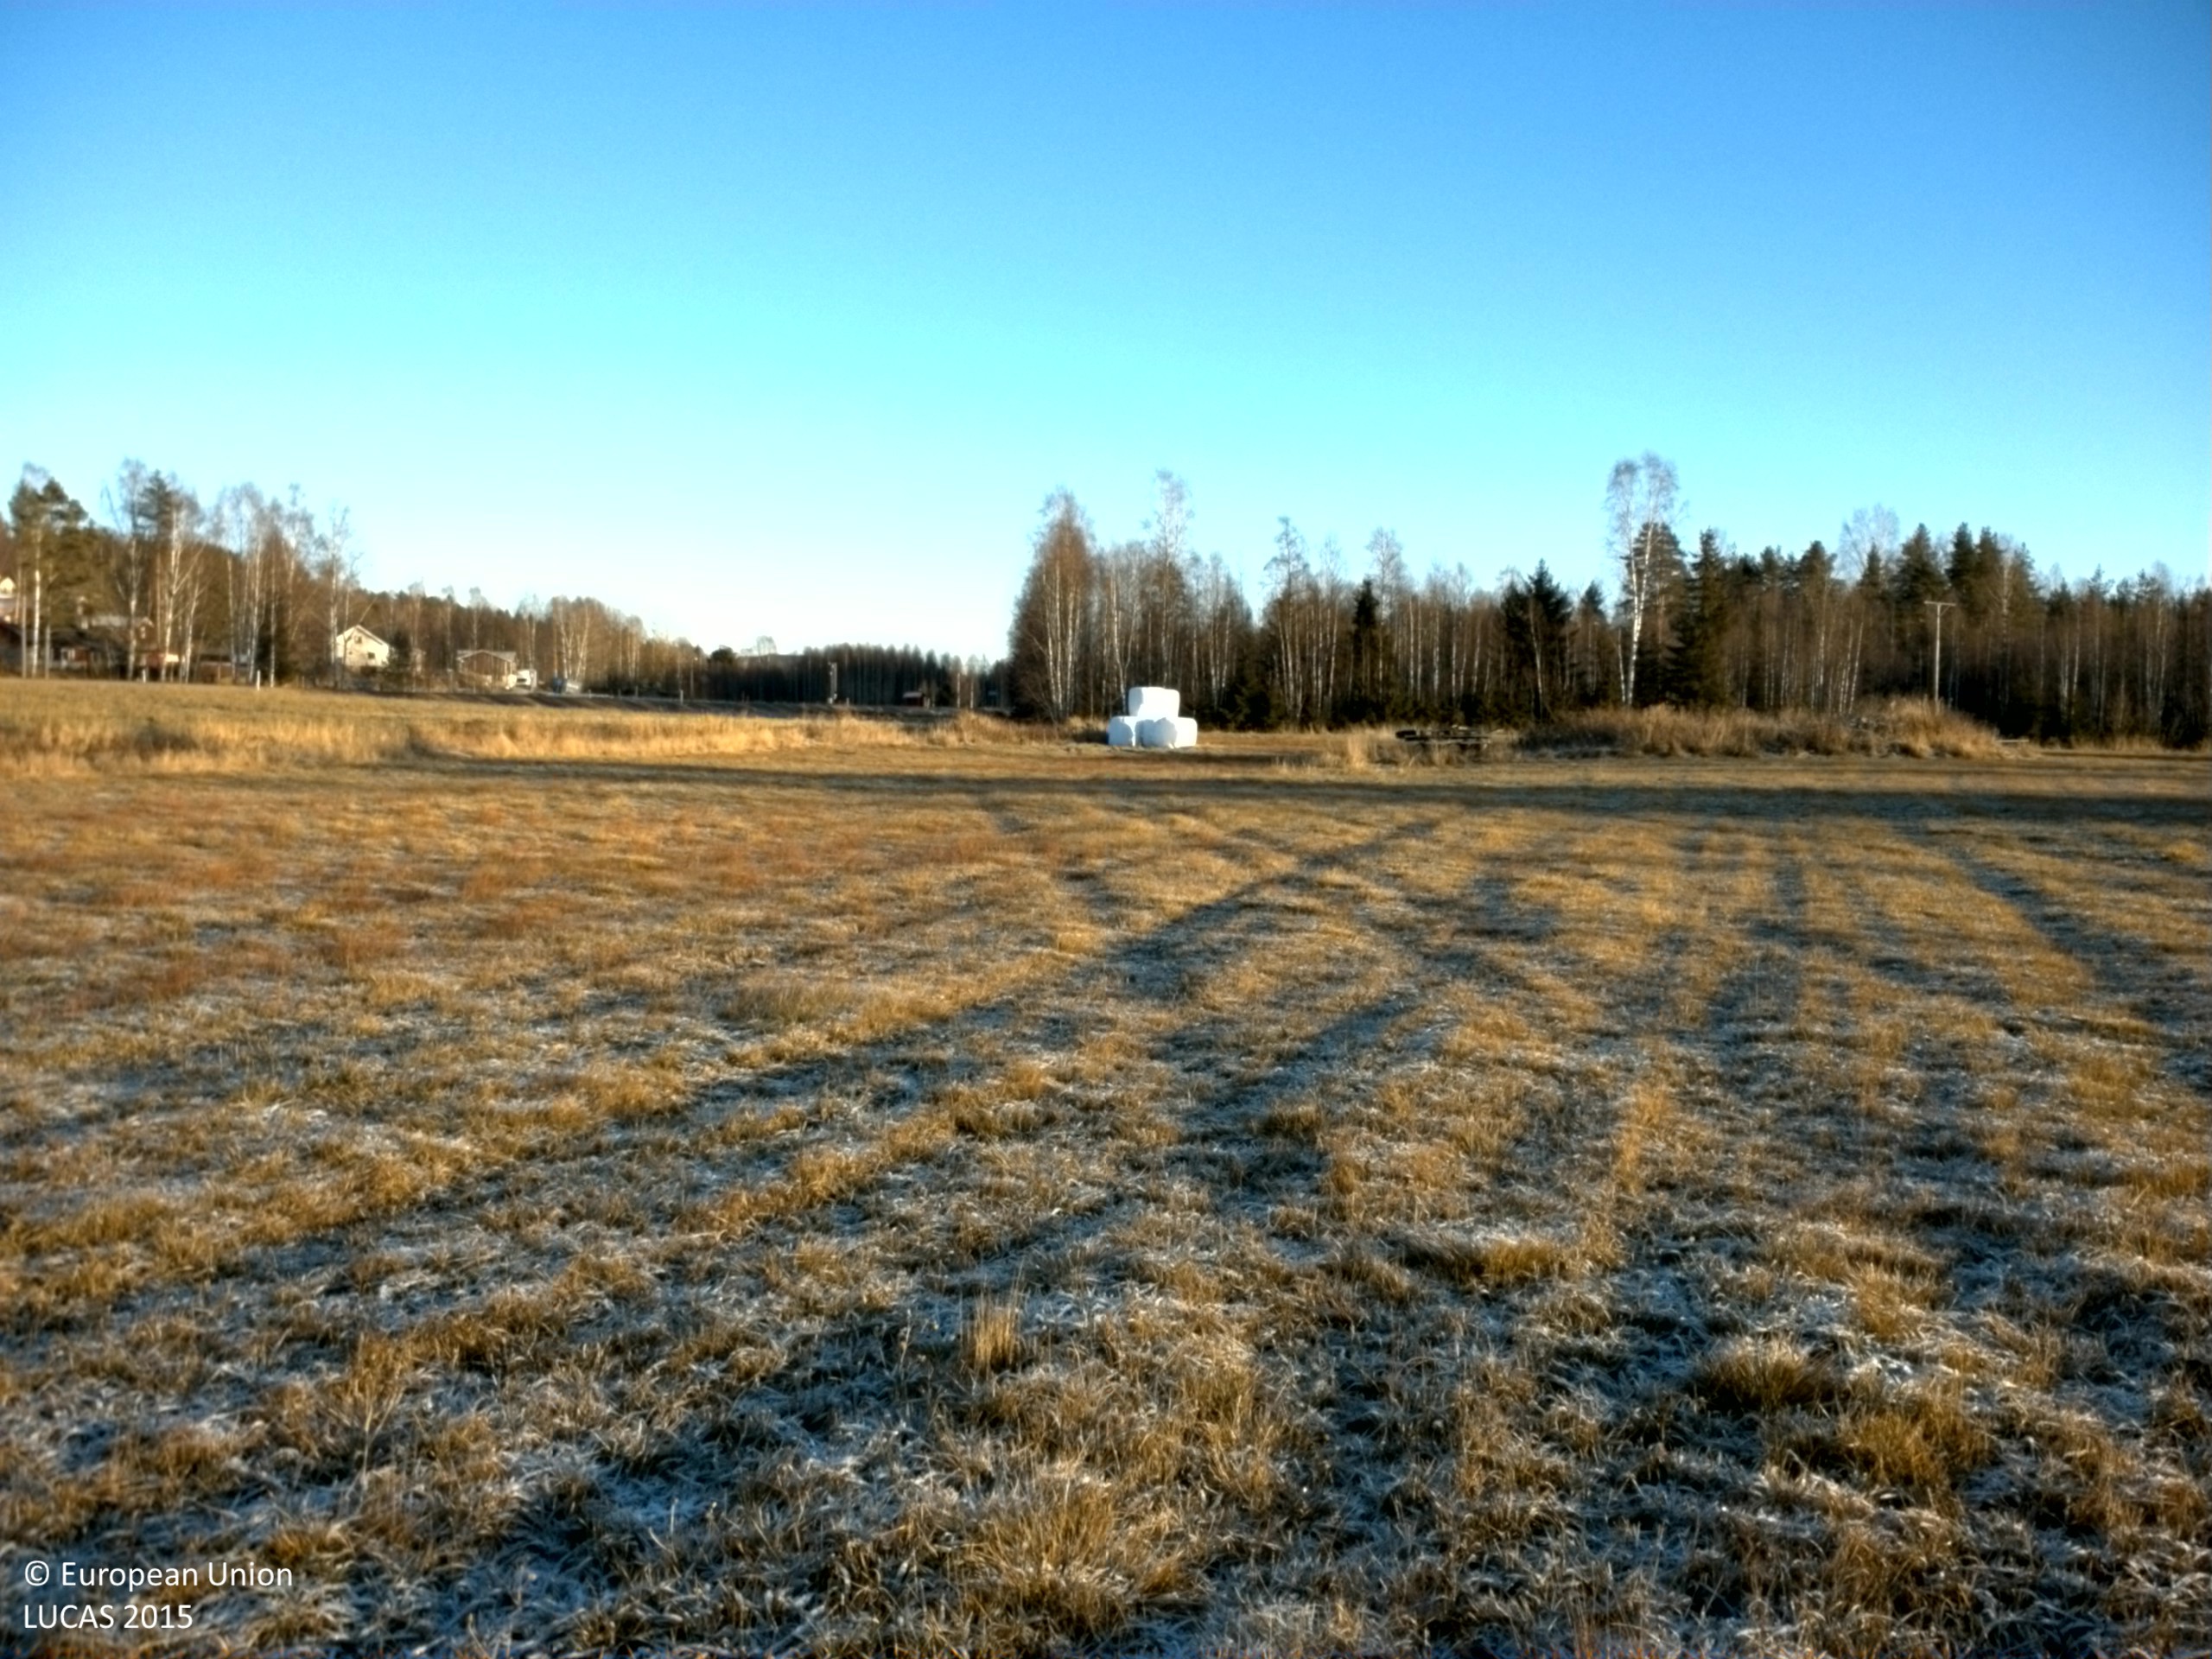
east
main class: Cropland
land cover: Mixed cereals for fodder
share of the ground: > 75 %
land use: Agriculture (excluding fallow land and kitchen gardens)
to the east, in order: Mixed cereals for fodder; Ditches and canals; Mixed cereals for fodder; Ditches and canals; Other bare soil; Ditches and canals; Tracks; Grass margins
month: November
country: SE
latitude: 61.8159
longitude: 16.1887
